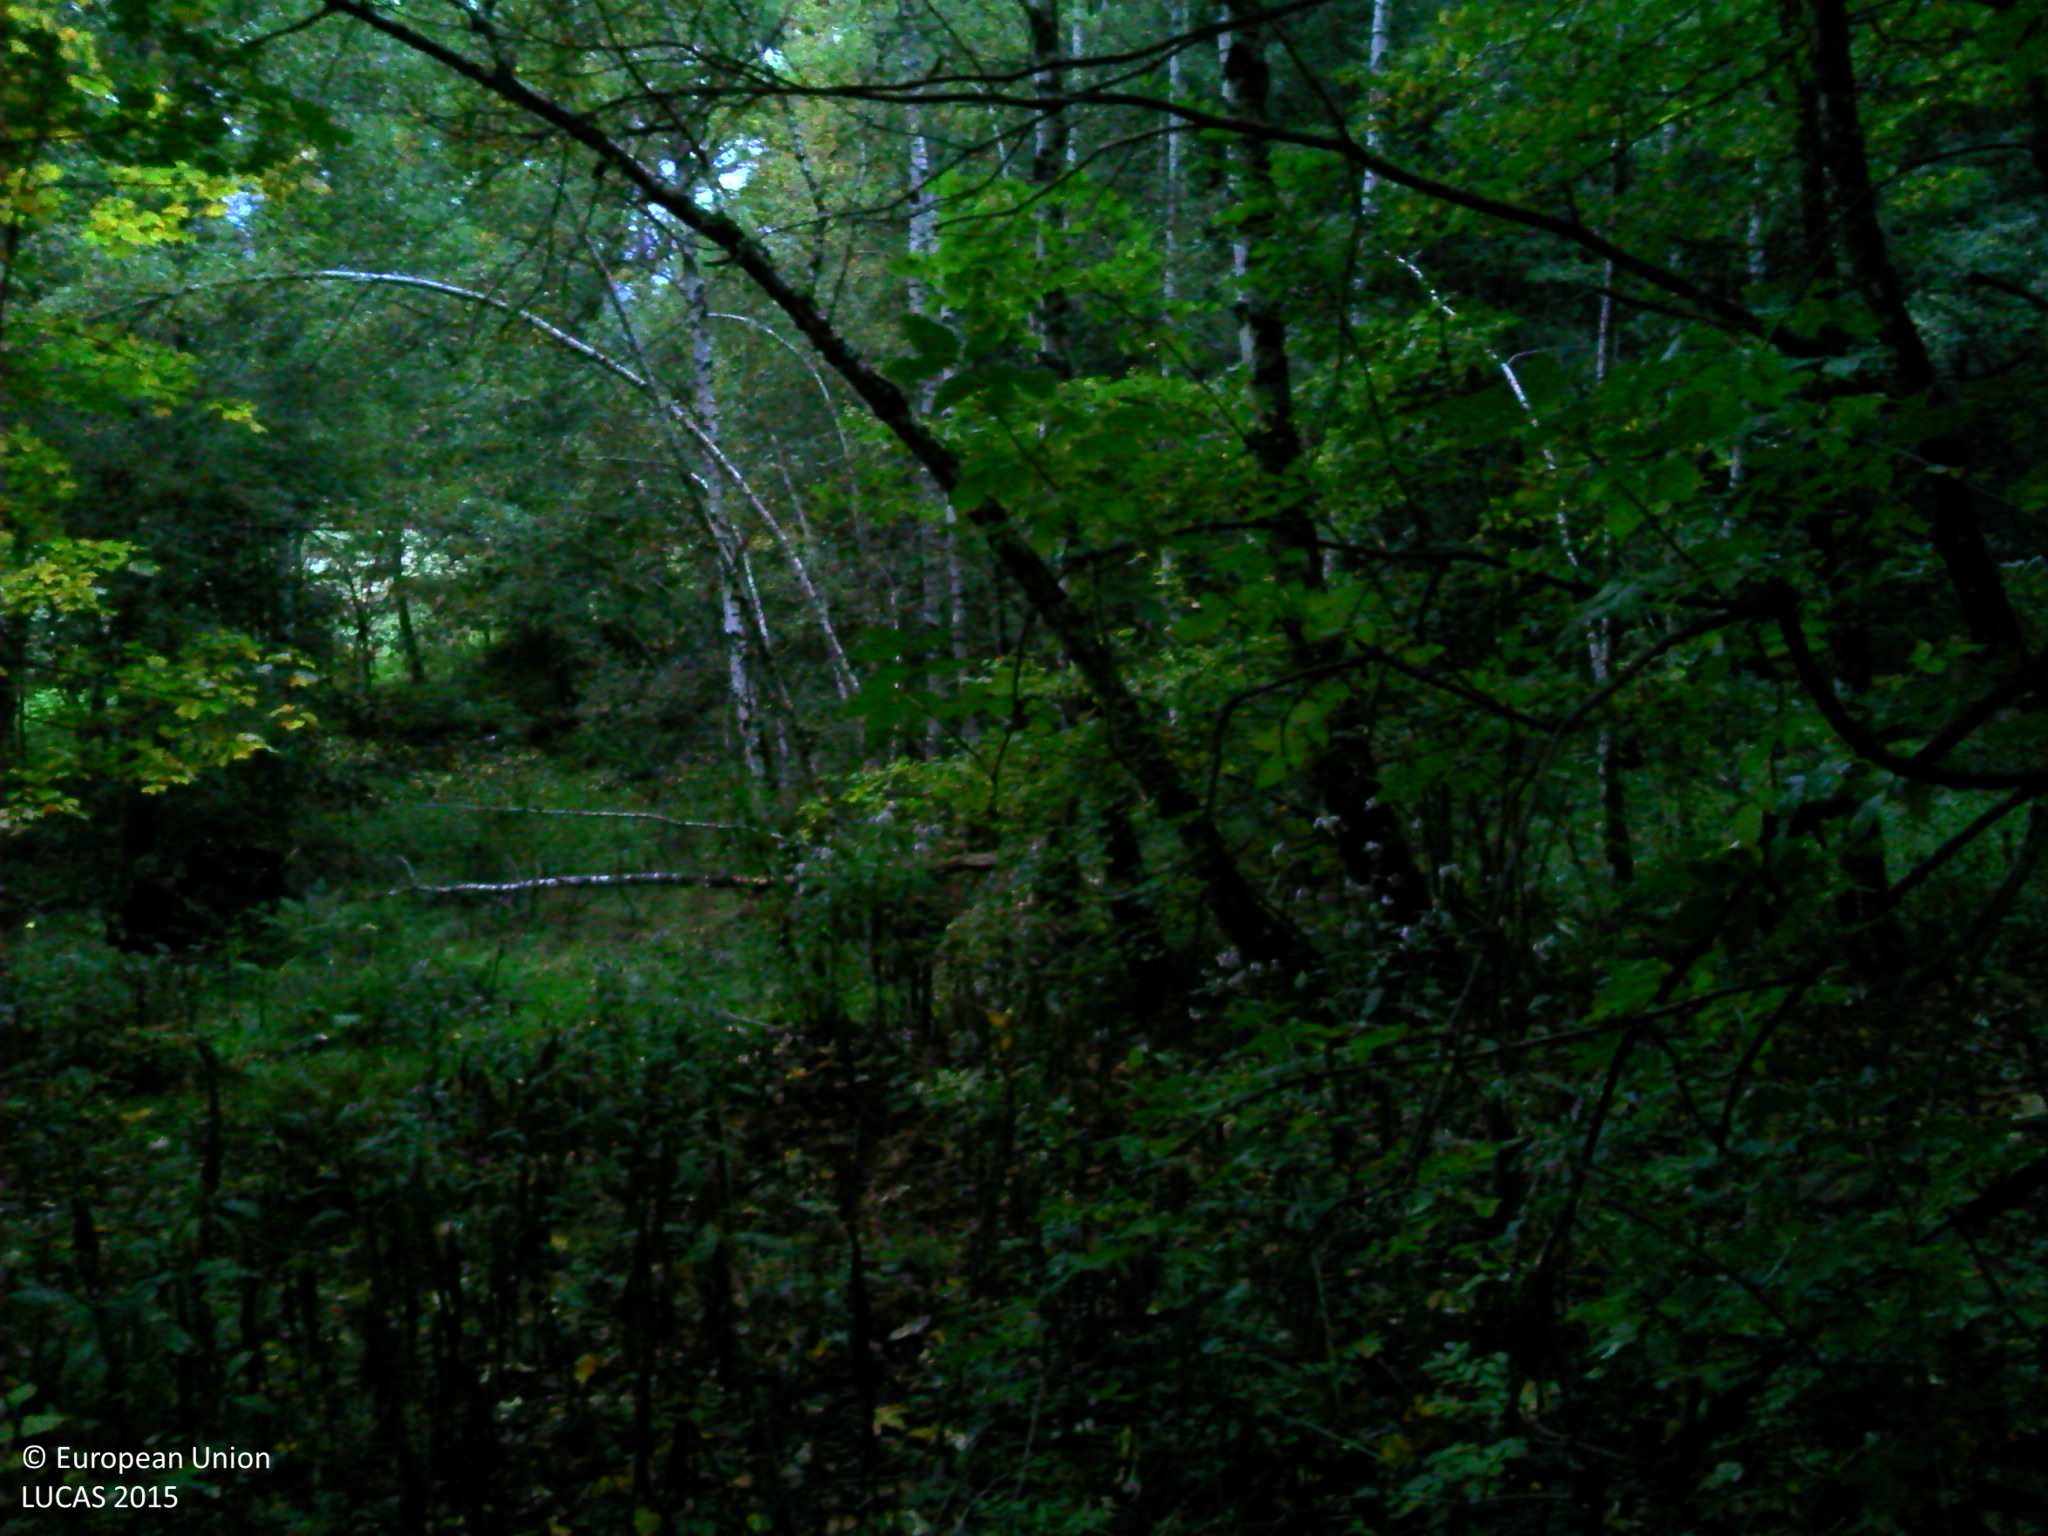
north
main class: Woodland
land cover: Broadleaved woodland
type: mesophytic deciduous forest
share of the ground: > 75 %
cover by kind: broadleaved forest trees 85 %, shrubs 10 %, herbaceous plants 5 %
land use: Forestry
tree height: > 5 m
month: October
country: FR
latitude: 45.8211
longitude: 3.6816
